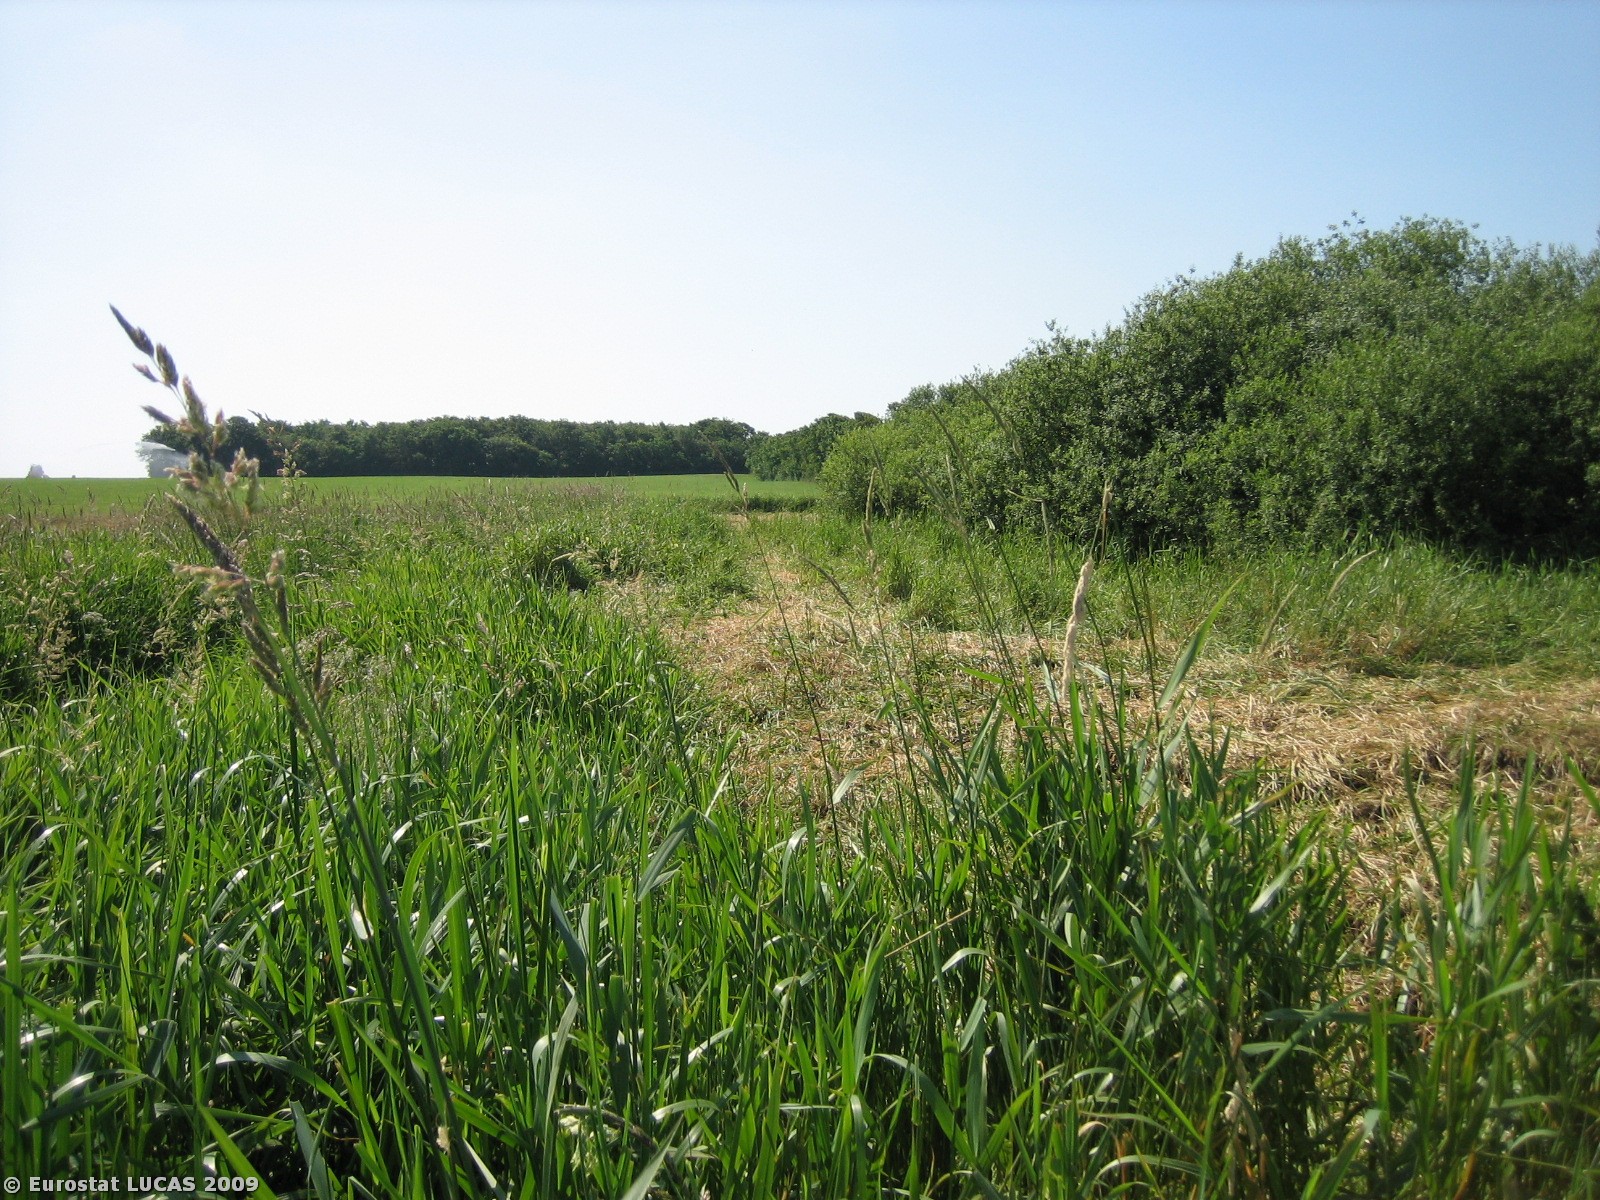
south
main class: Grassland
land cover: Grassland without tree/shrub cover
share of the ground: > 75 %
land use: Agriculture (excluding fallow land and kitchen gardens)
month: July
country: DK
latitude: 55.4093
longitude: 8.8165
